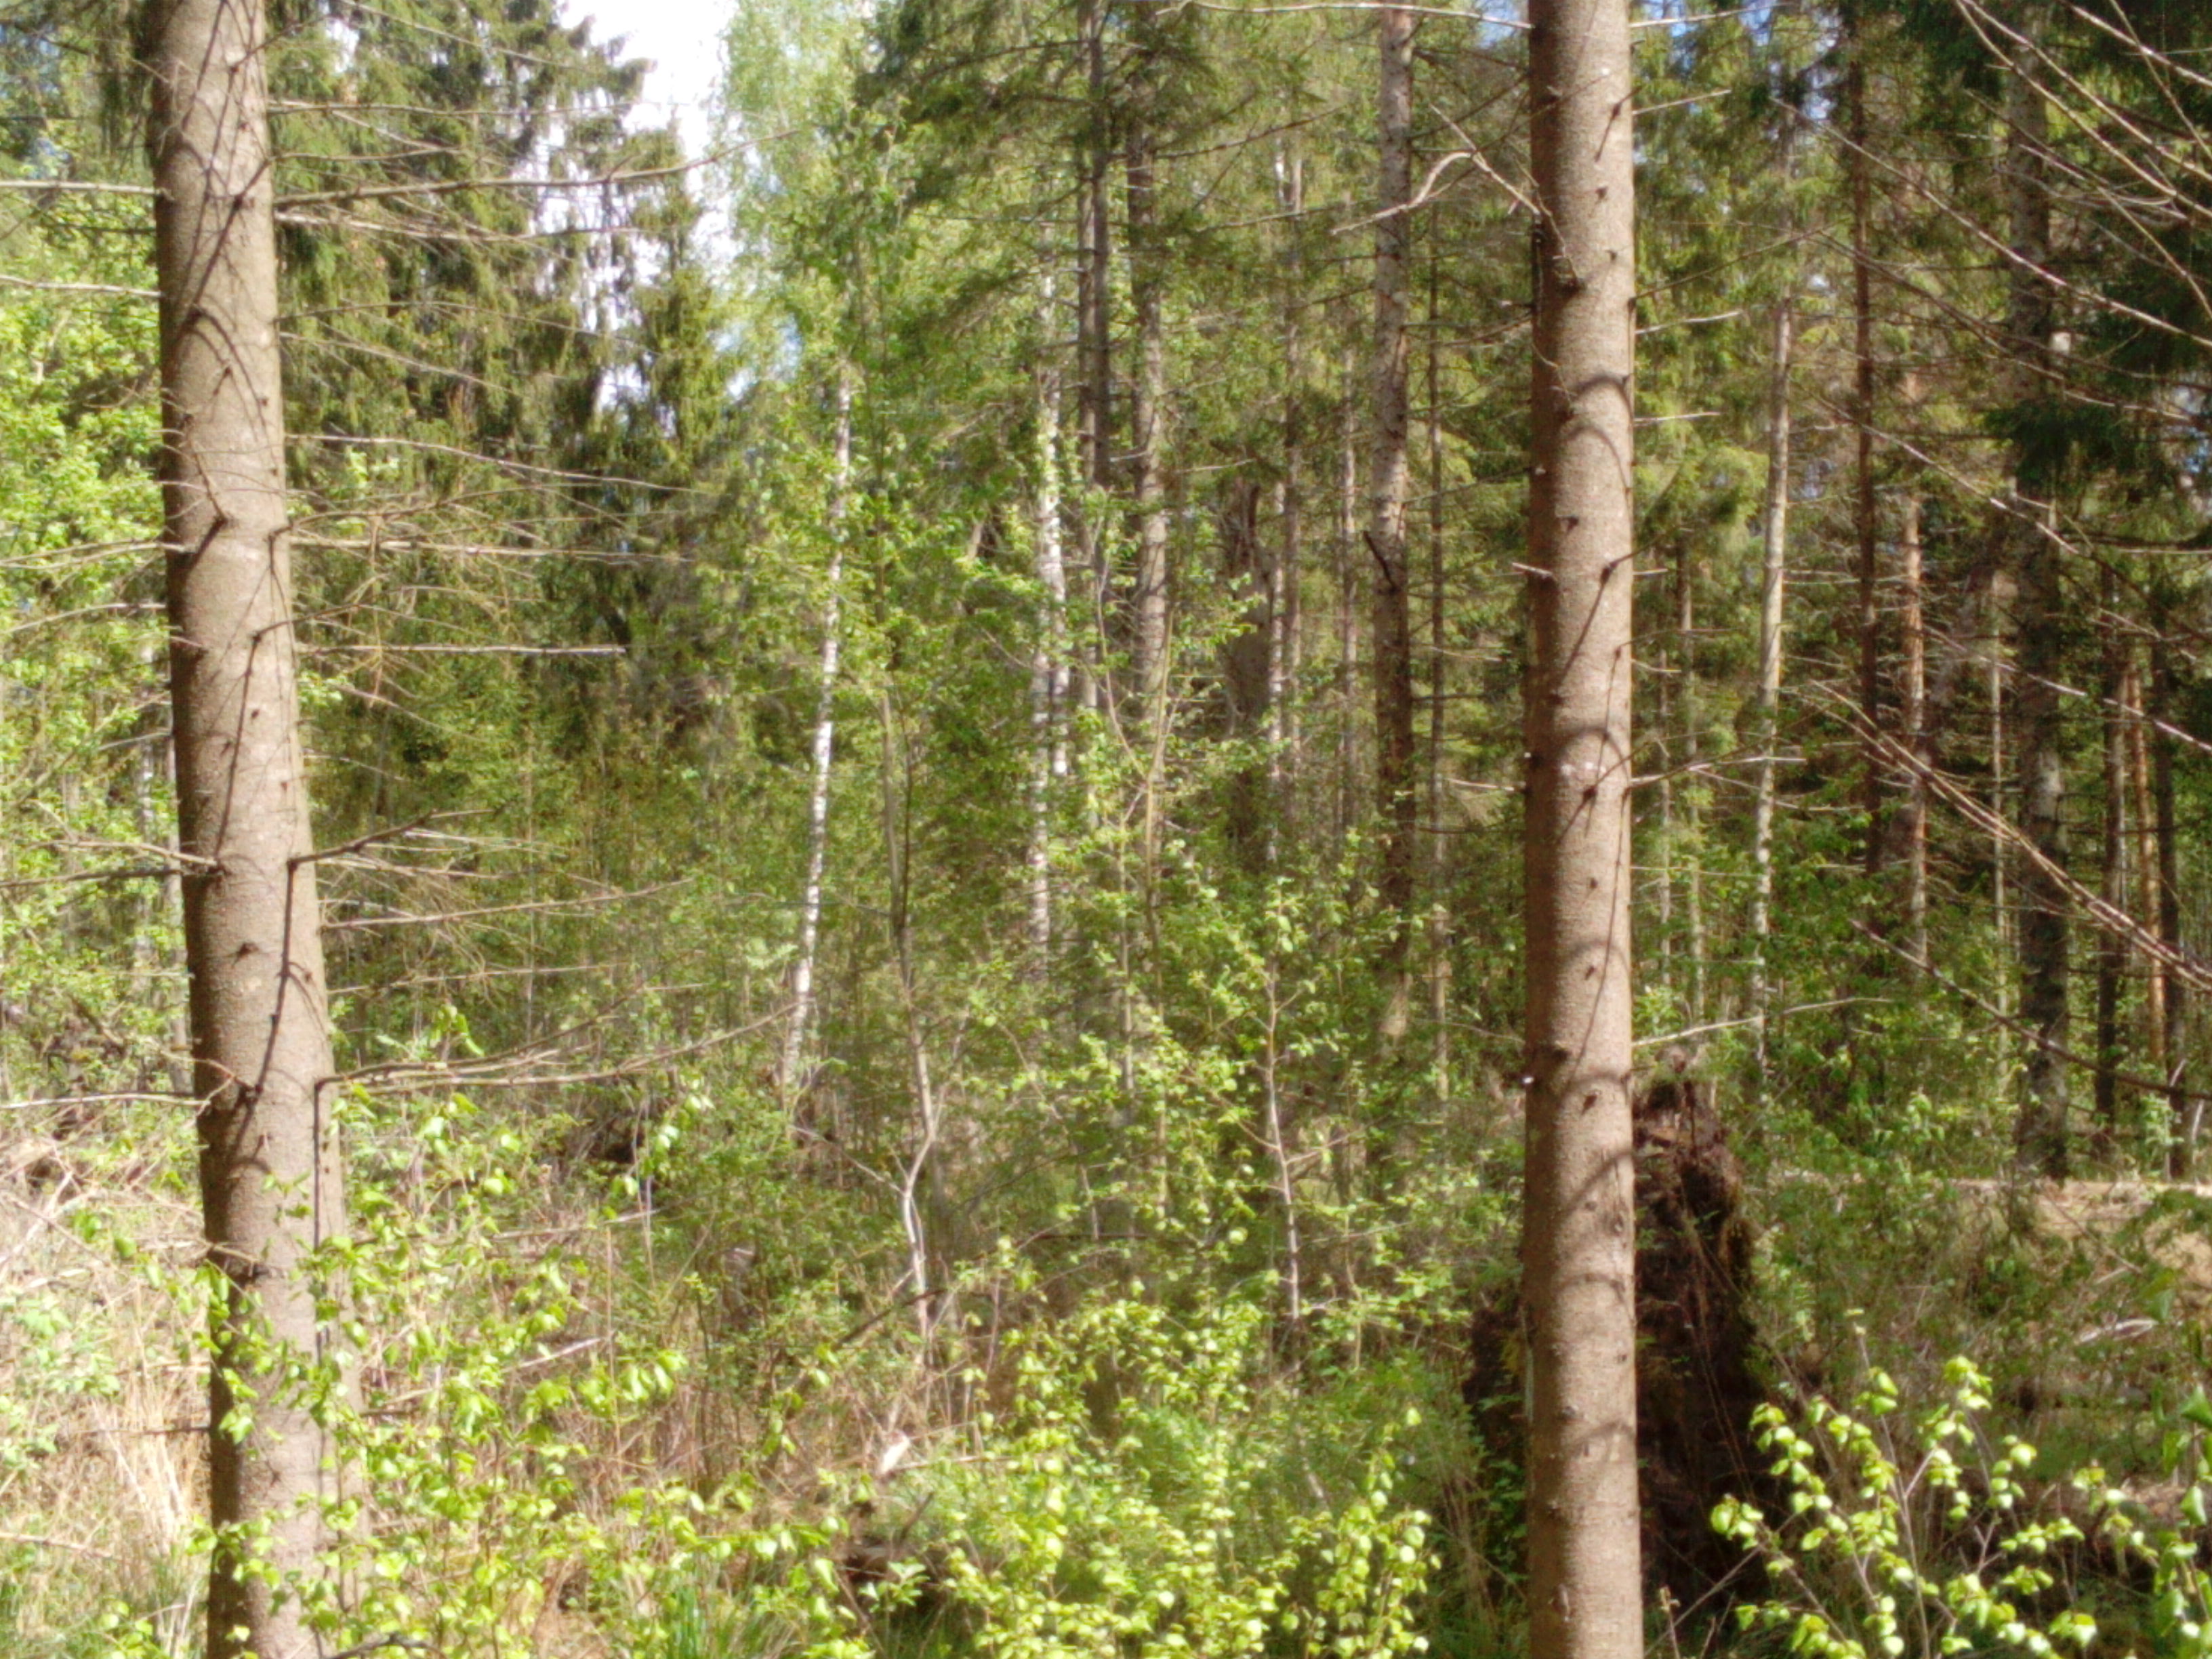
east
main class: Woodland
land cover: Spruce dominated mixed woodland
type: hemiboreal forest and nemoral coniferous forest and mixed broadleaved-coniferous forest
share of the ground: > 75 %
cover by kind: coniferous forest trees 75 %, broadleaved forest trees 25 %
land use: Forestry
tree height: > 5 m
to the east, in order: Spruce dominated mixed woodland; Broadleaved woodland; Ditches and canals; Sand; Ditches and canals; Broadleaved woodland; Spruce dominated mixed woodland
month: May
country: LV
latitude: 56.7404
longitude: 22.8636
